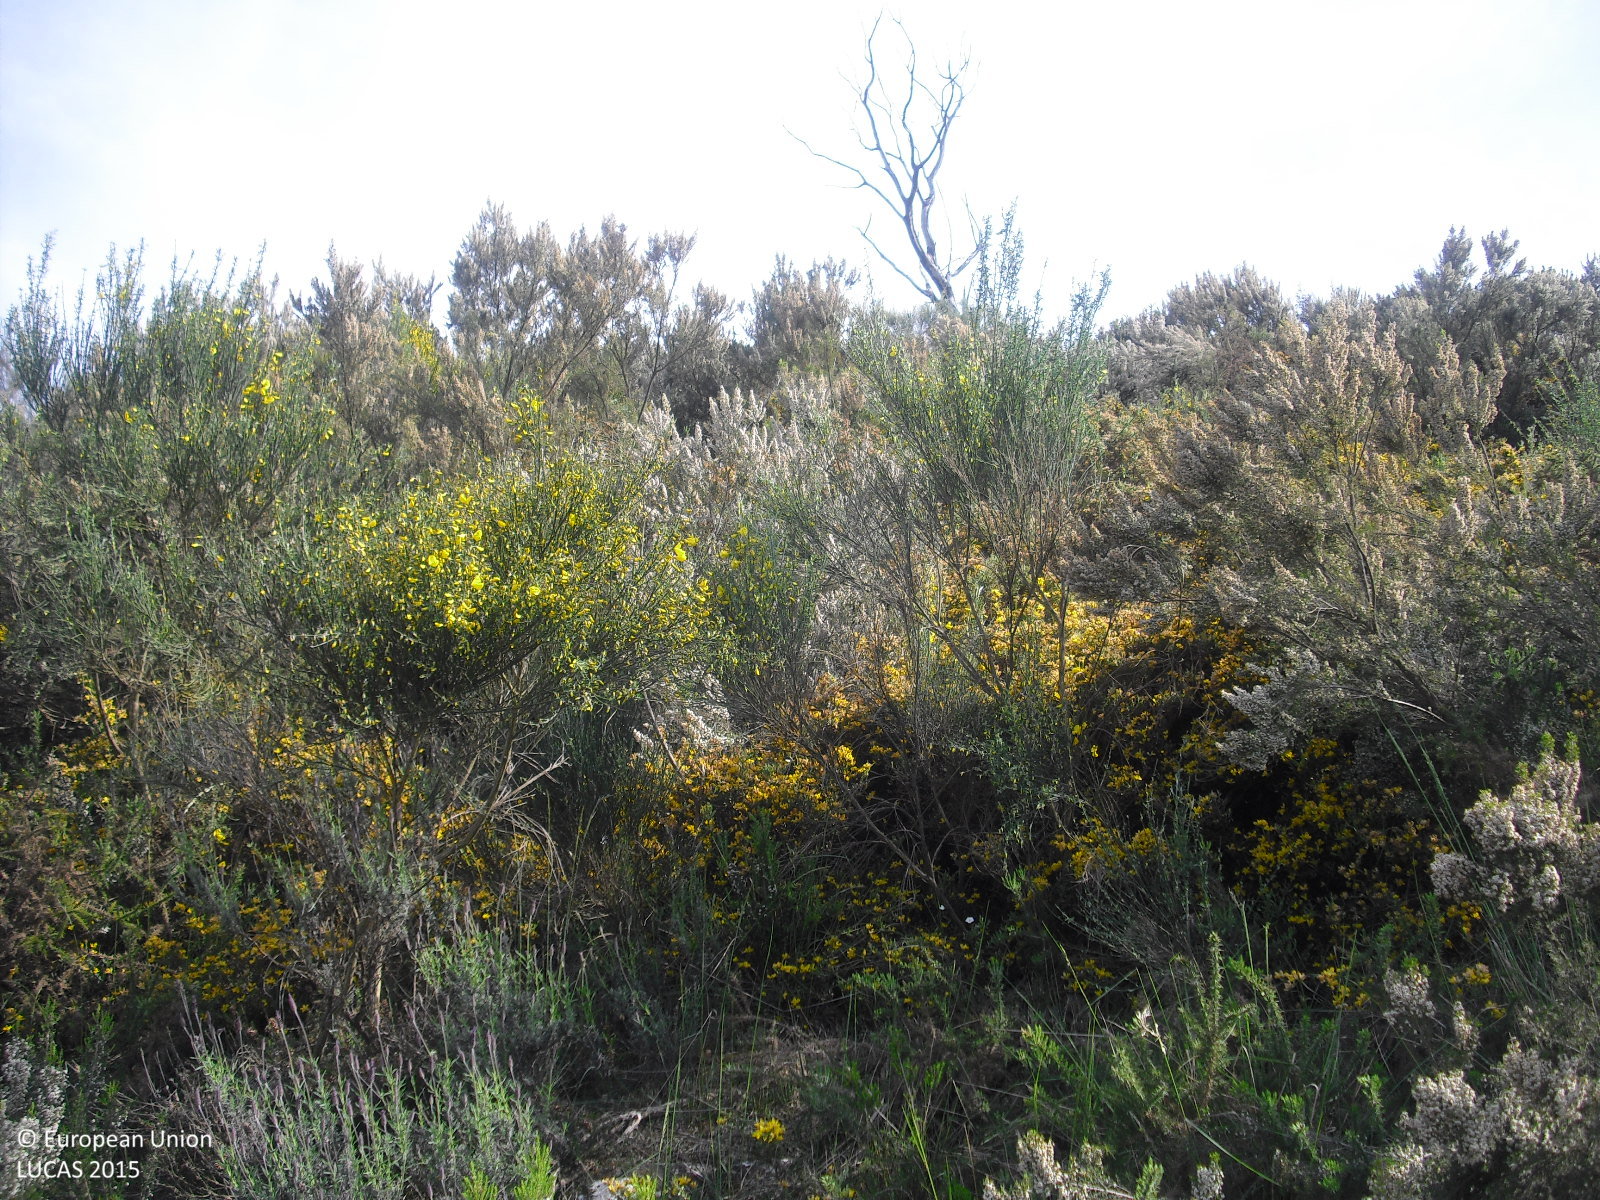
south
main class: Shrubland
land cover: Shrubland without tree cover
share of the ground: > 75 %
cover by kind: shrubs 100 %
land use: Semi-natural and natural areas not in use
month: May
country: ES
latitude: 41.8754
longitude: -7.2732
